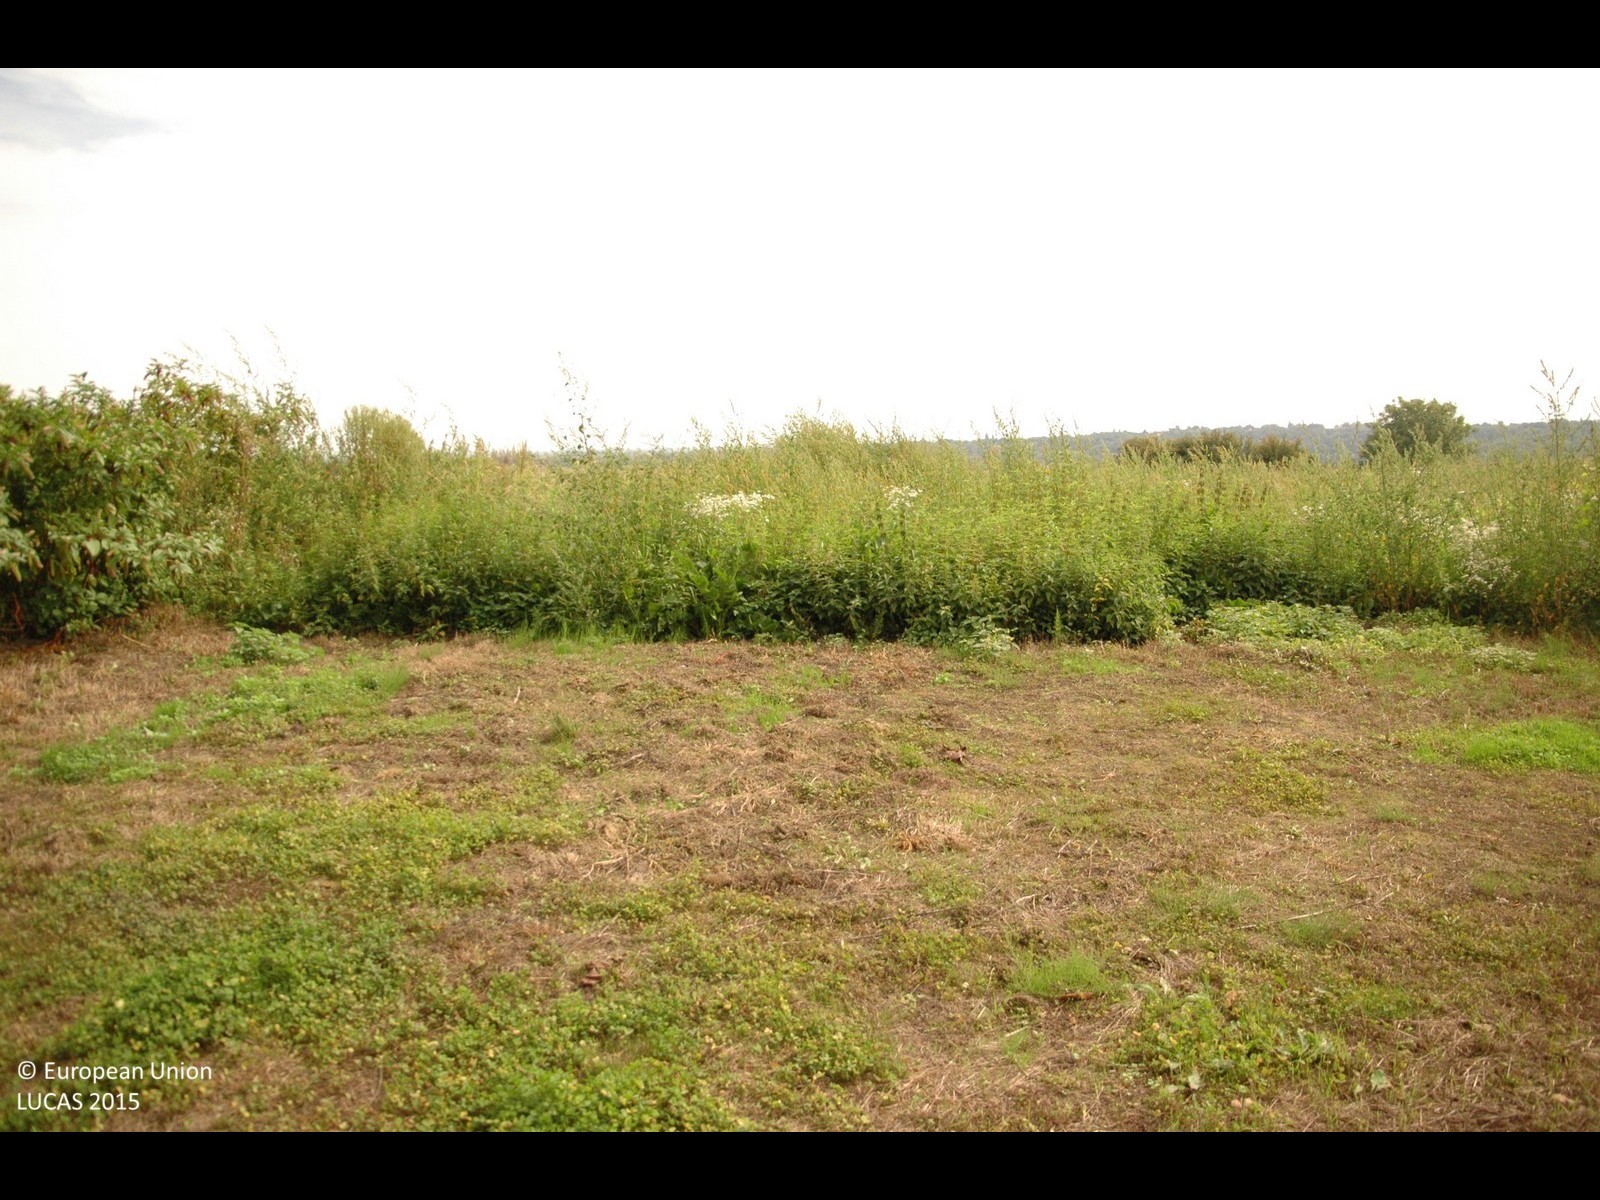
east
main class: Grassland
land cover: Grassland with sparse tree/shrub cover
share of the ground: > 75 %
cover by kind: herbaceous plants 95 %, broadleaved forest trees 5 %
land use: Agriculture (excluding fallow land and kitchen gardens)
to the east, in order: Grassland with sparse tree/shrub cover; Abandoned hedges; Maize; Other fresh vegetables; Maize; Other fresh vegetables
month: September
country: HR
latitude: 46.0729
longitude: 16.9185
